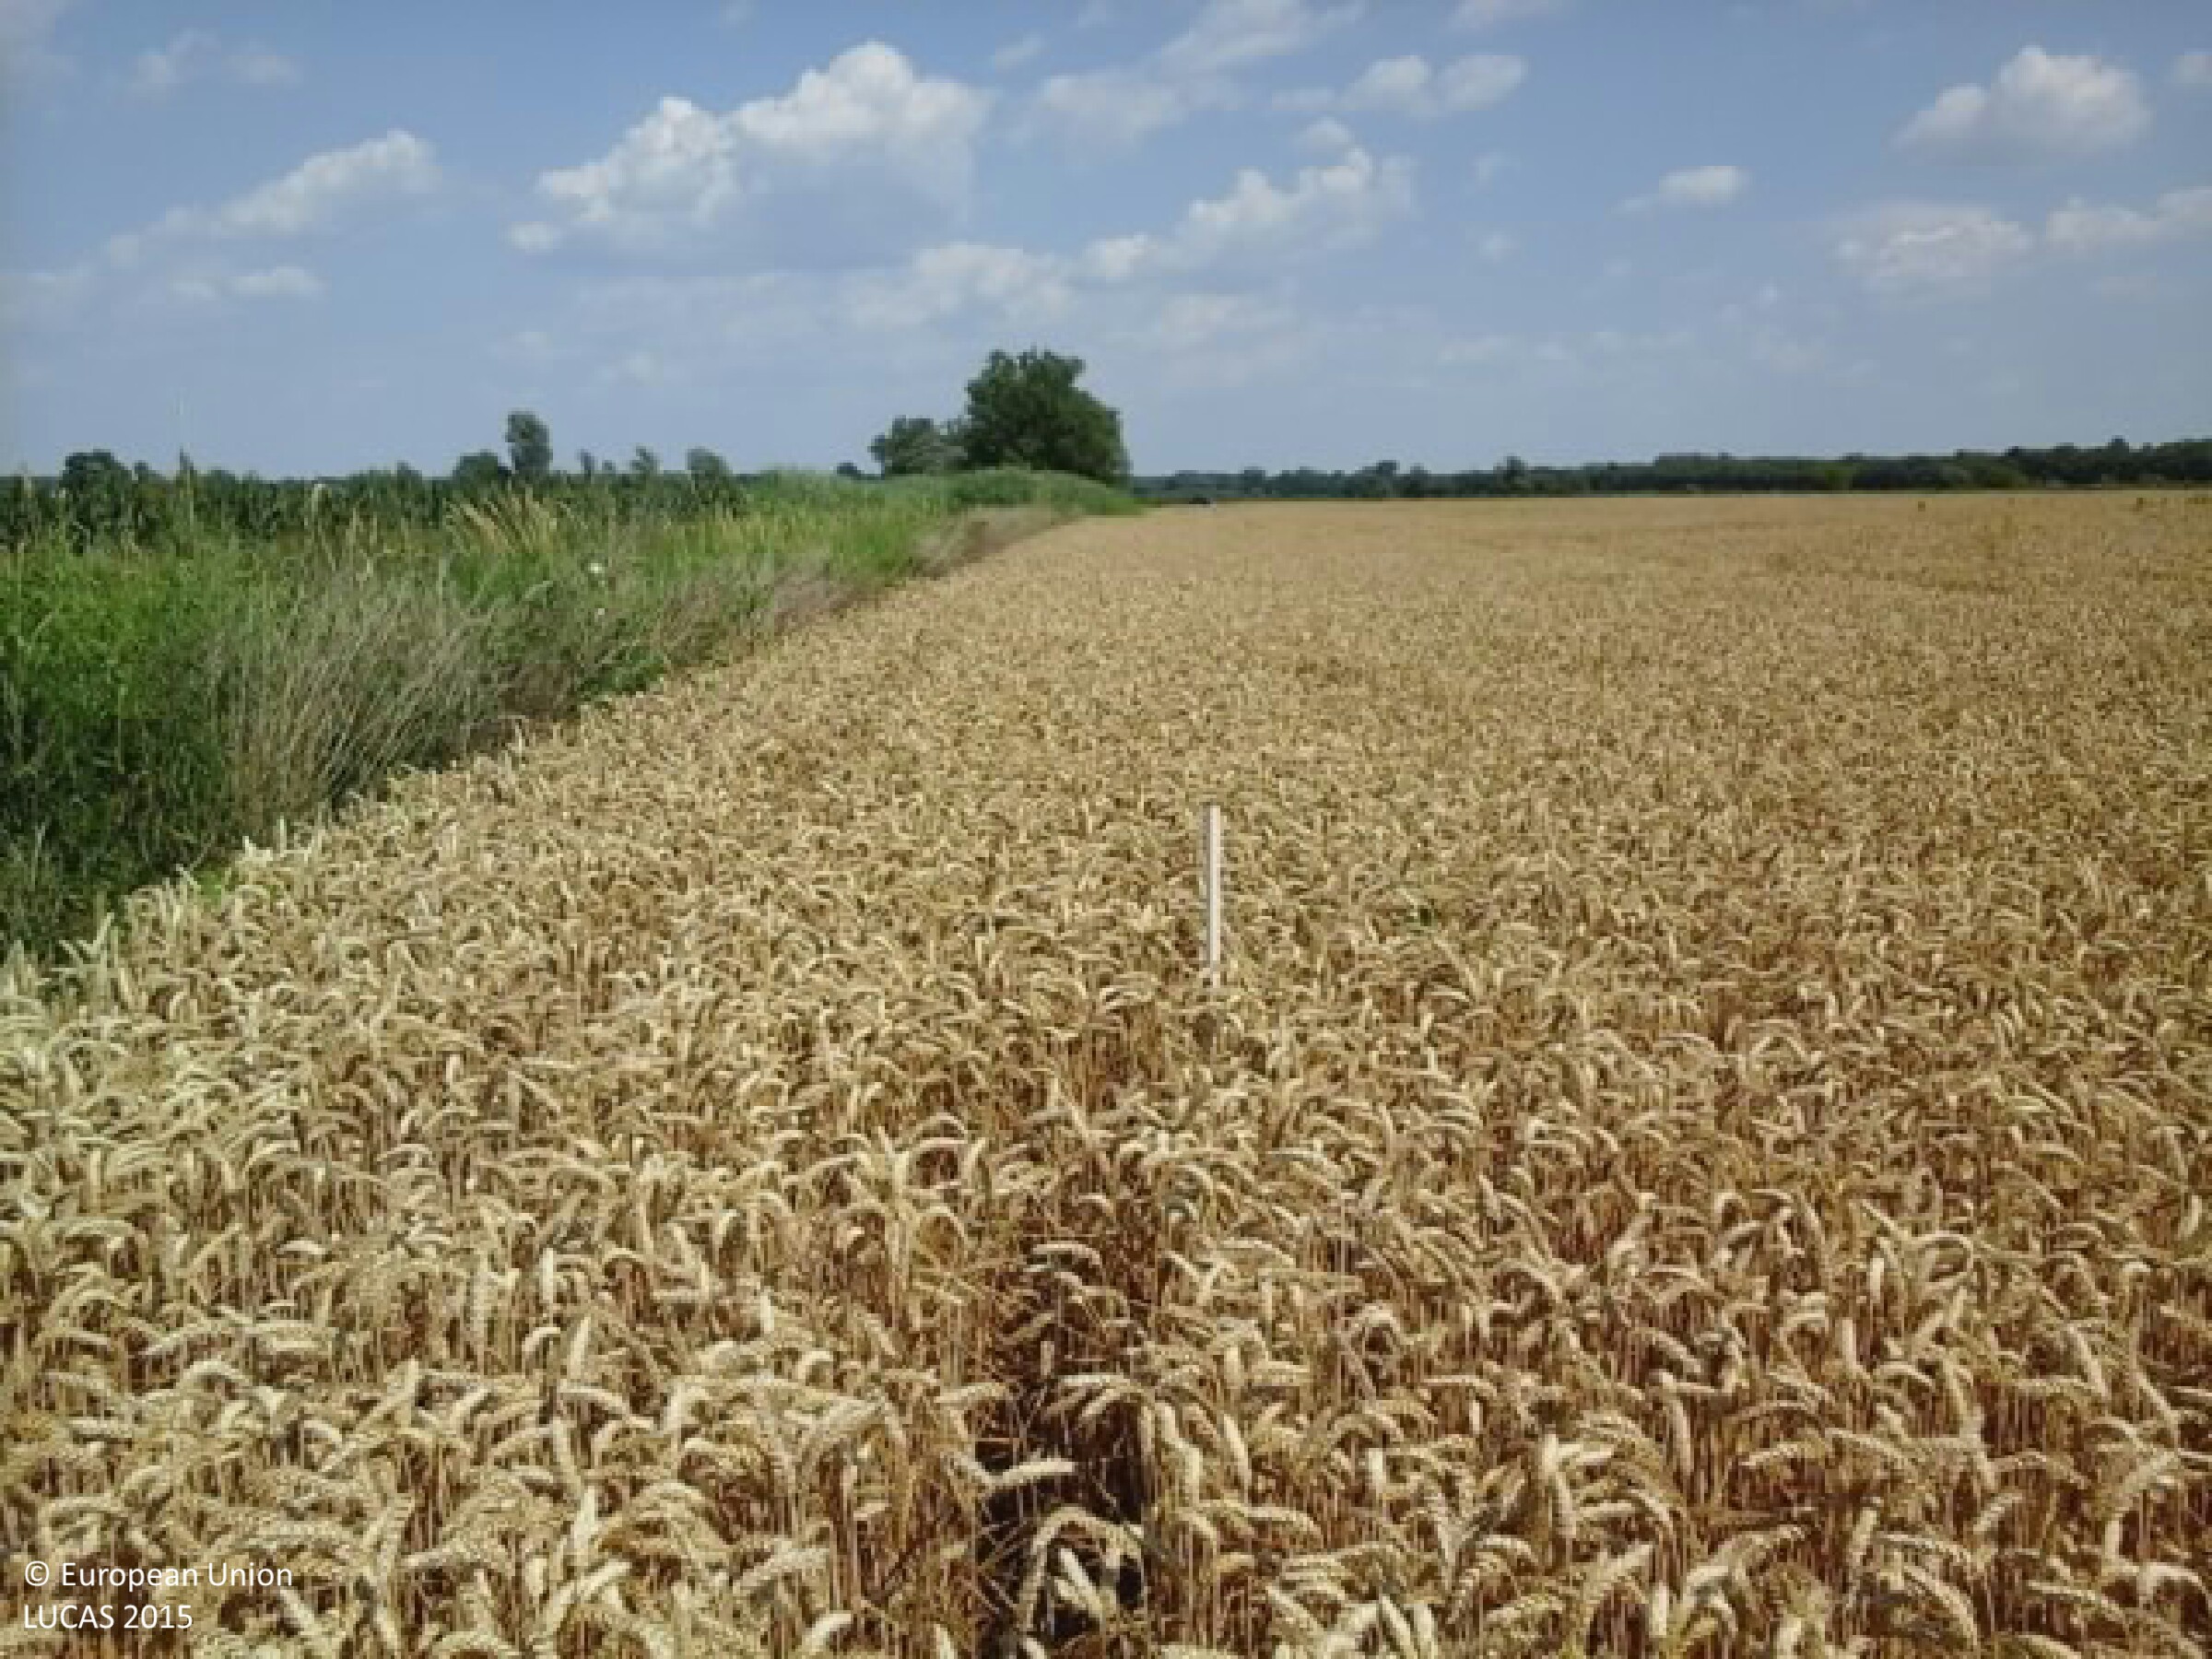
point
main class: Cropland
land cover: Common wheat
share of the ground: > 75 %
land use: Agriculture (excluding fallow land and kitchen gardens)
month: July
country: HU
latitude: 45.9121
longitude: 18.8412
